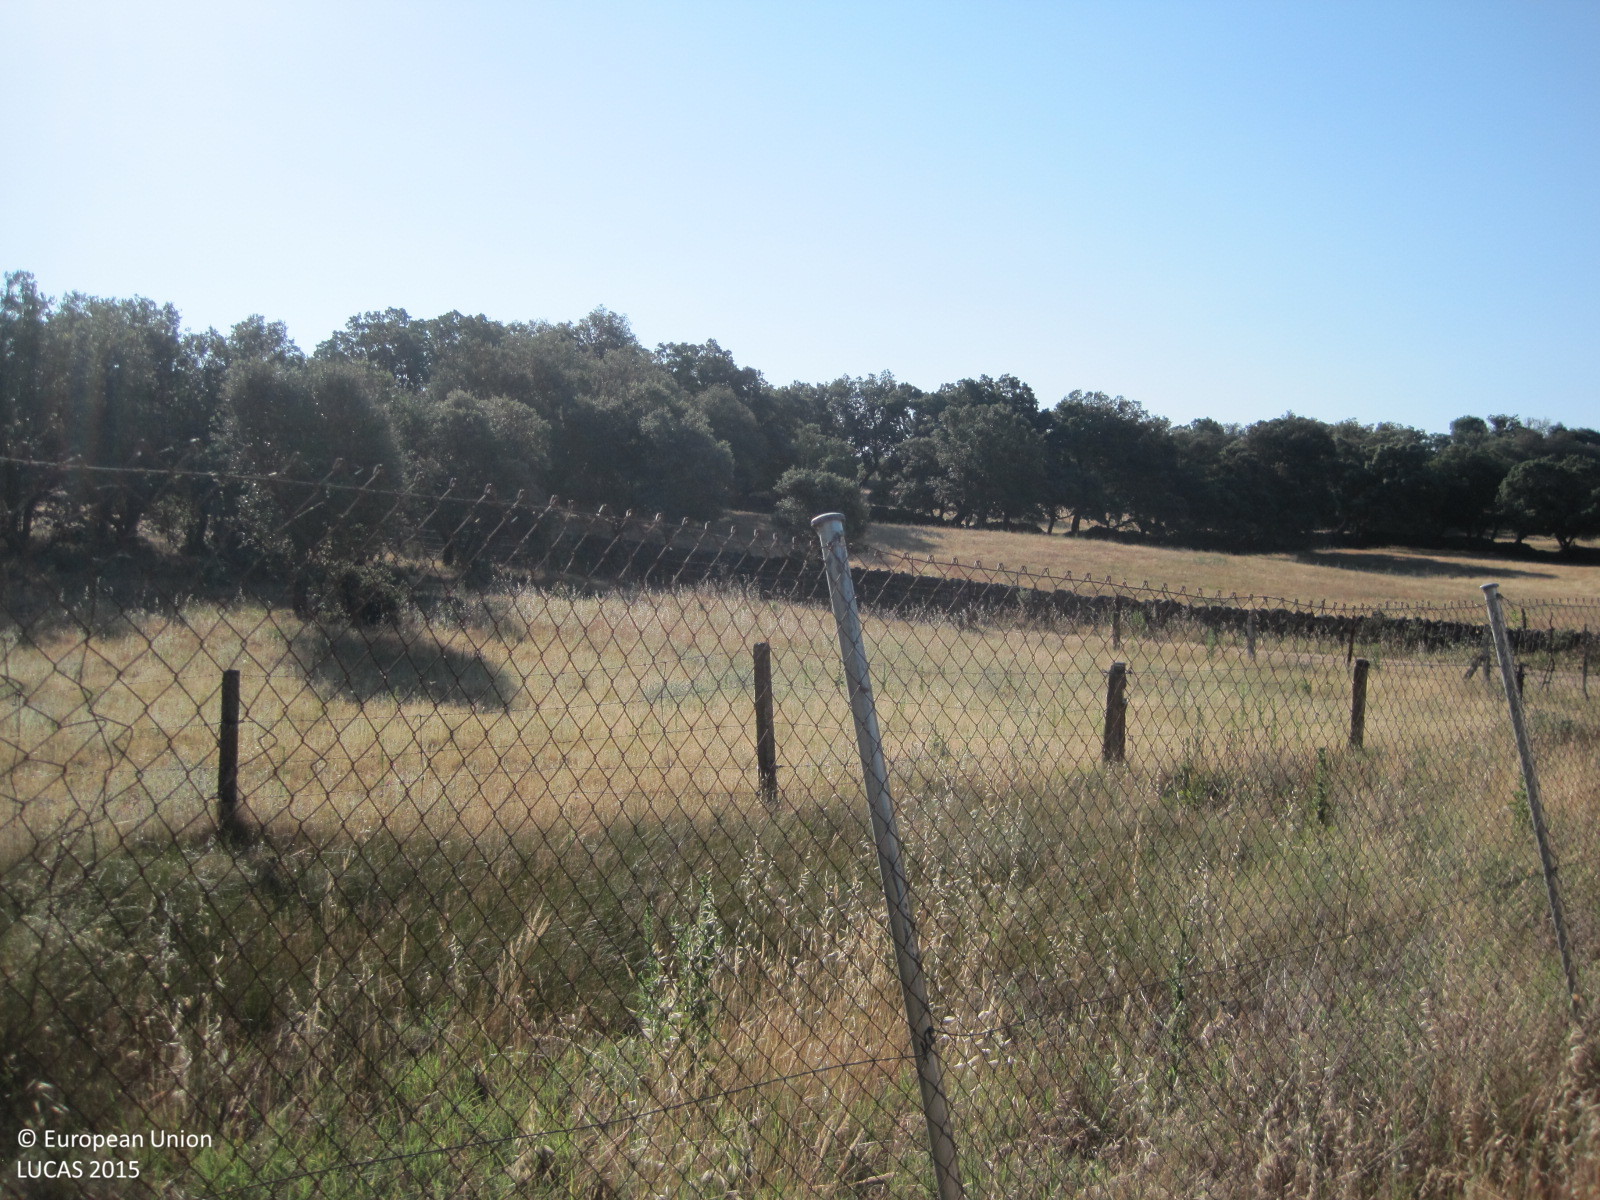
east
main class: Grassland
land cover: Grassland with sparse tree/shrub cover
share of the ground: > 75 %
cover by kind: herbaceous plants 95 %, broadleaved forest trees 5 %
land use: Agriculture (excluding fallow land and kitchen gardens)
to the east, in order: Grassland with sparse tree/shrub cover; Fences; Broadleaved woodland; Fences; Grass margins; Tracks; Grass margins; Broadleaved woodland; Grass margins; Tracks; Grass margins; Fences; Grassland with sparse tree/shrub cover; Broadleaved woodland
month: May
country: ES
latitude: 40.2566
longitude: -4.8072
